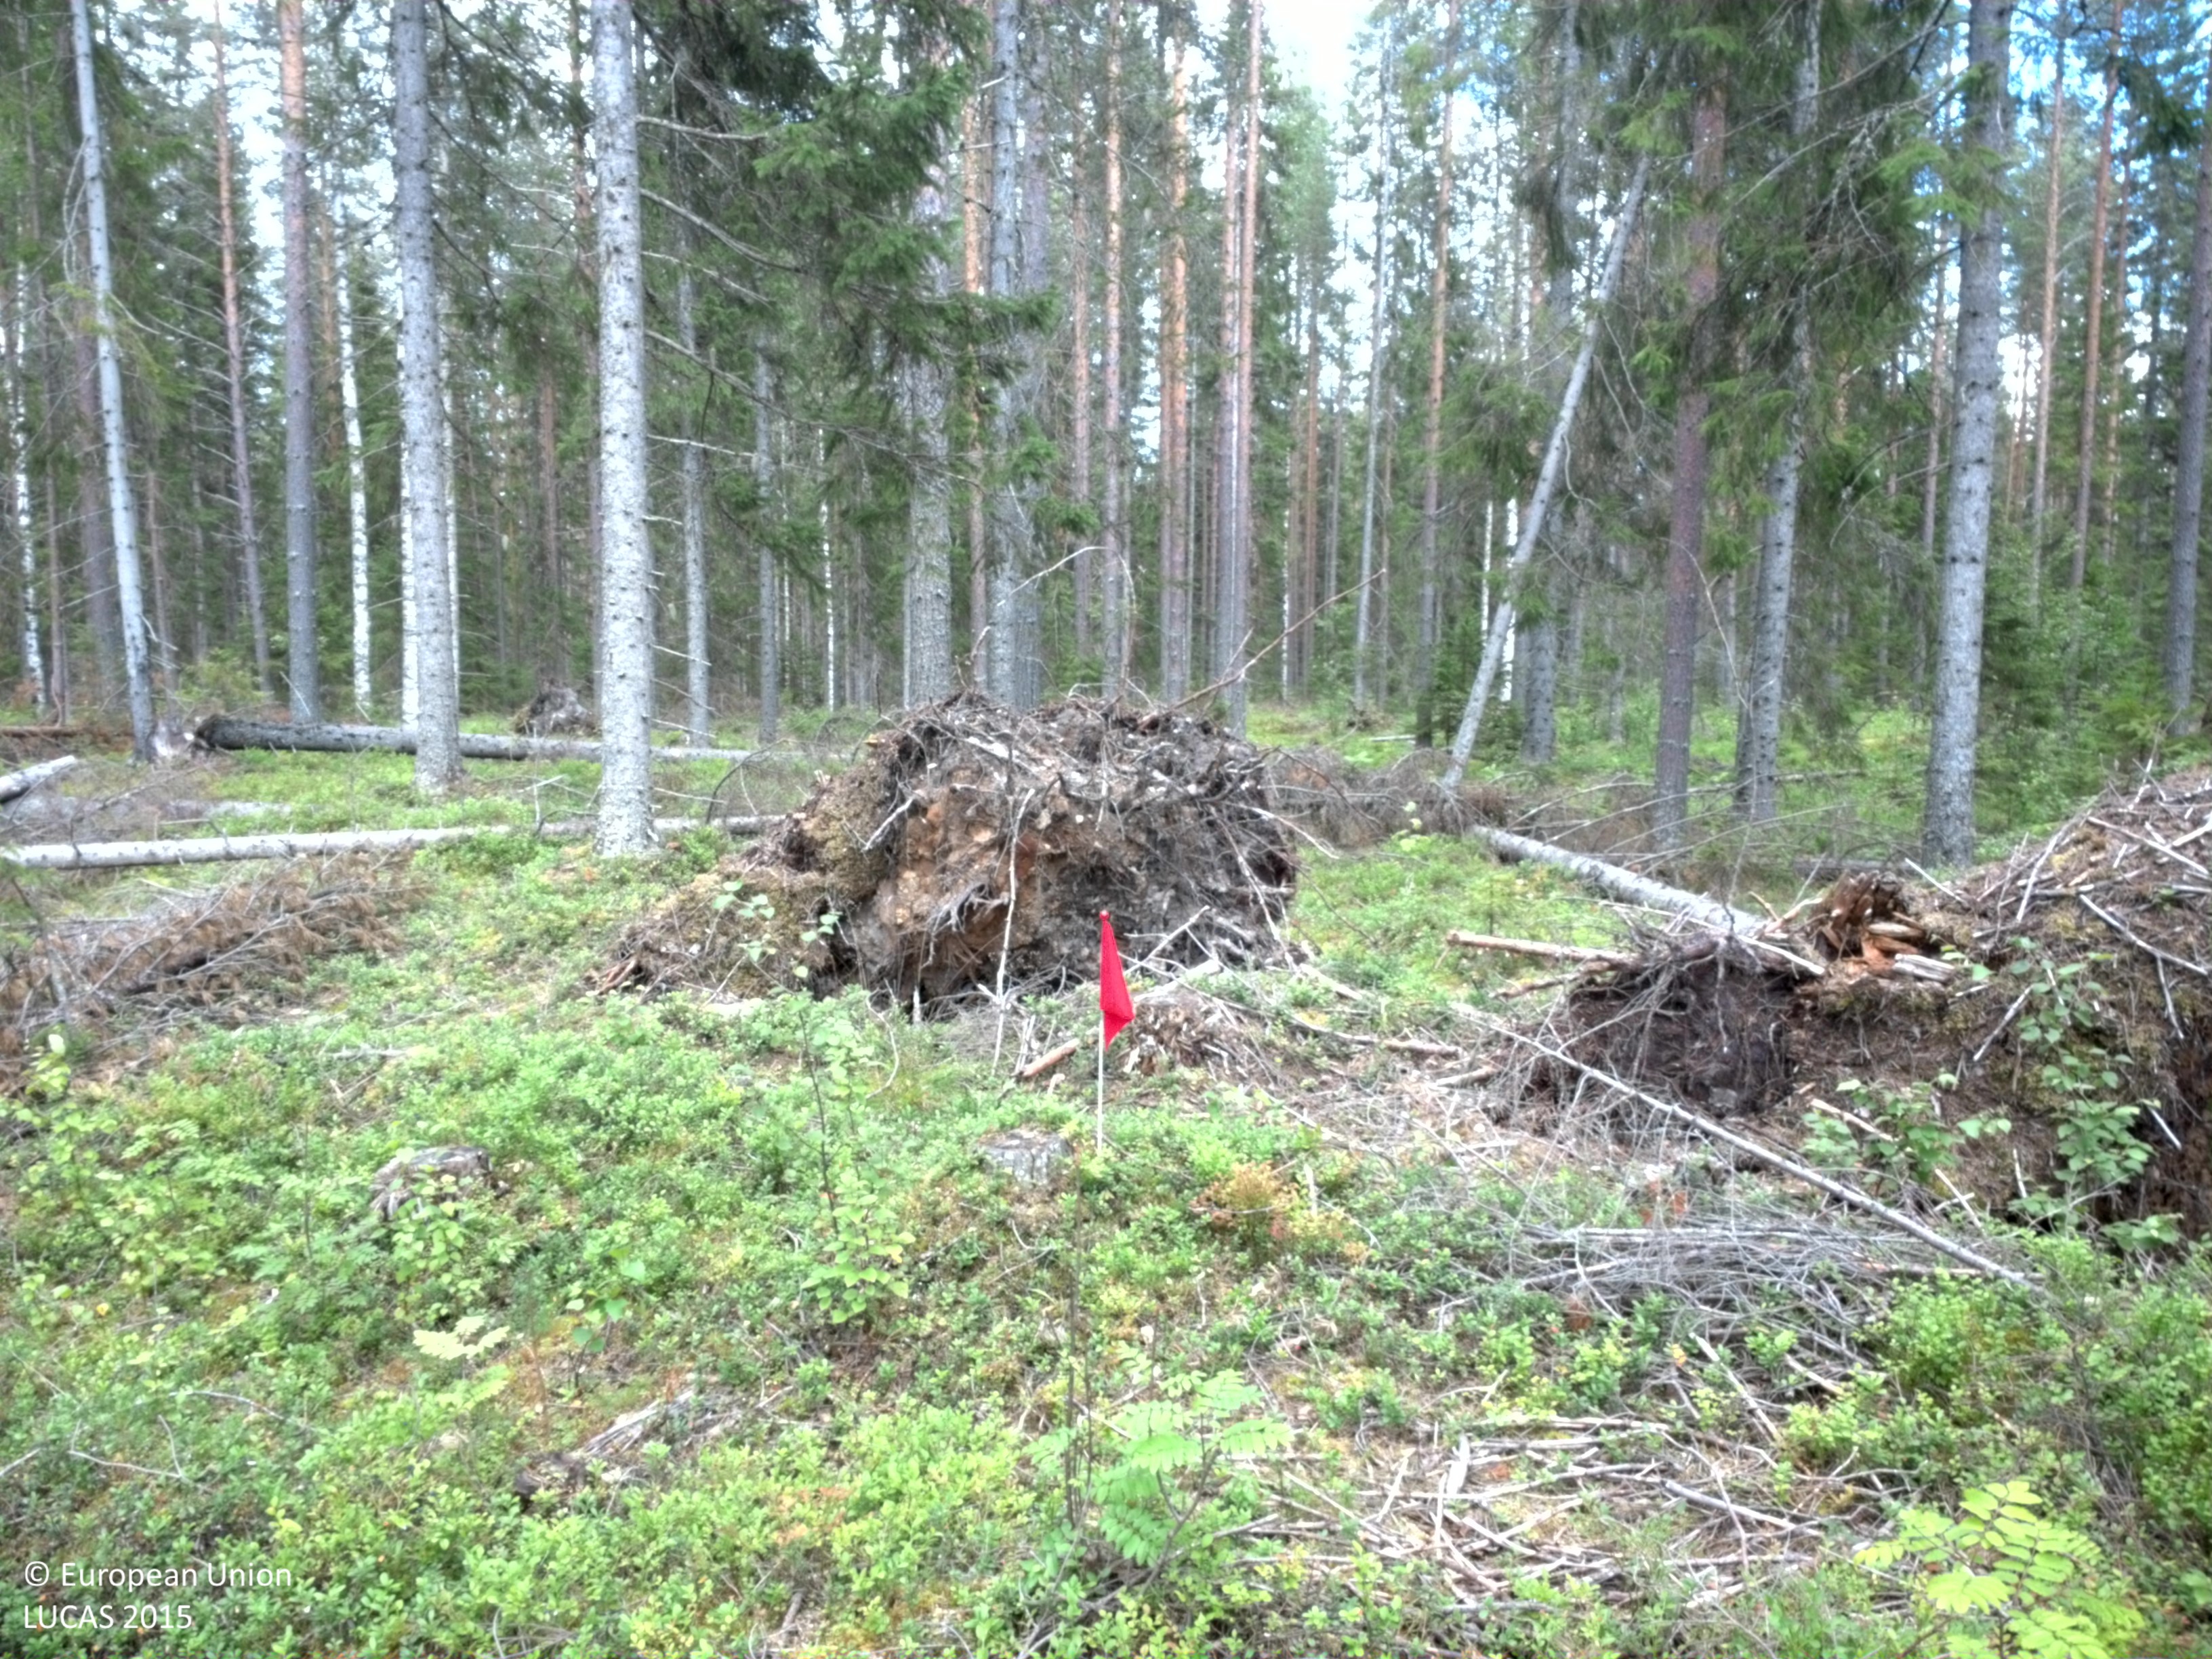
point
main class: Woodland
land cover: Pine dominated coniferous woodland
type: boreal forest
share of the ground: 50 - 75 %
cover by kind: coniferous forest trees 60 %, shrubs 30 %, broadleaved forest trees 5 %, lichens and mosses 5 %
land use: Forestry
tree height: > 5 m
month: August
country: SE
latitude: 64.6113
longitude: 20.8274
